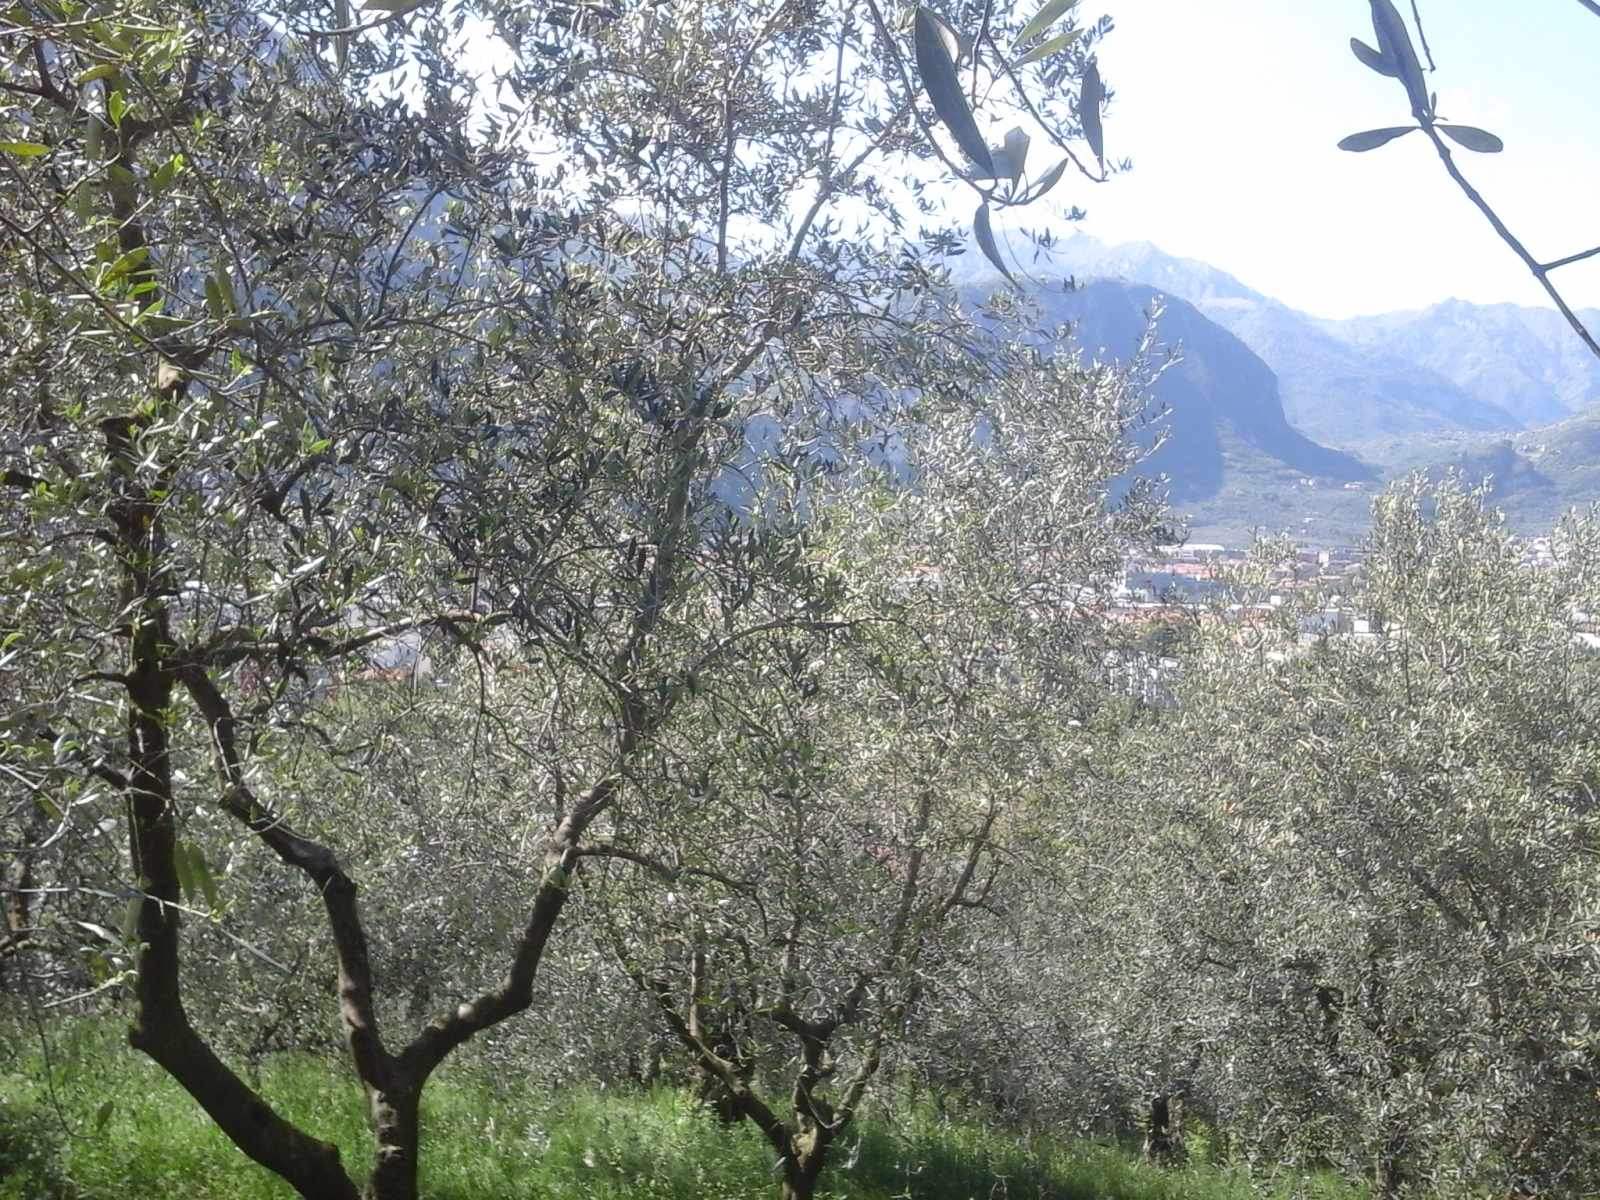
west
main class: Cropland
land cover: Olive groves
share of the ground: > 75 %
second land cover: Grassland without tree/shrub cover
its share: > 75 %
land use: Agriculture (excluding fallow land and kitchen gardens)
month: May
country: IT
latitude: 45.8793
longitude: 10.8619
